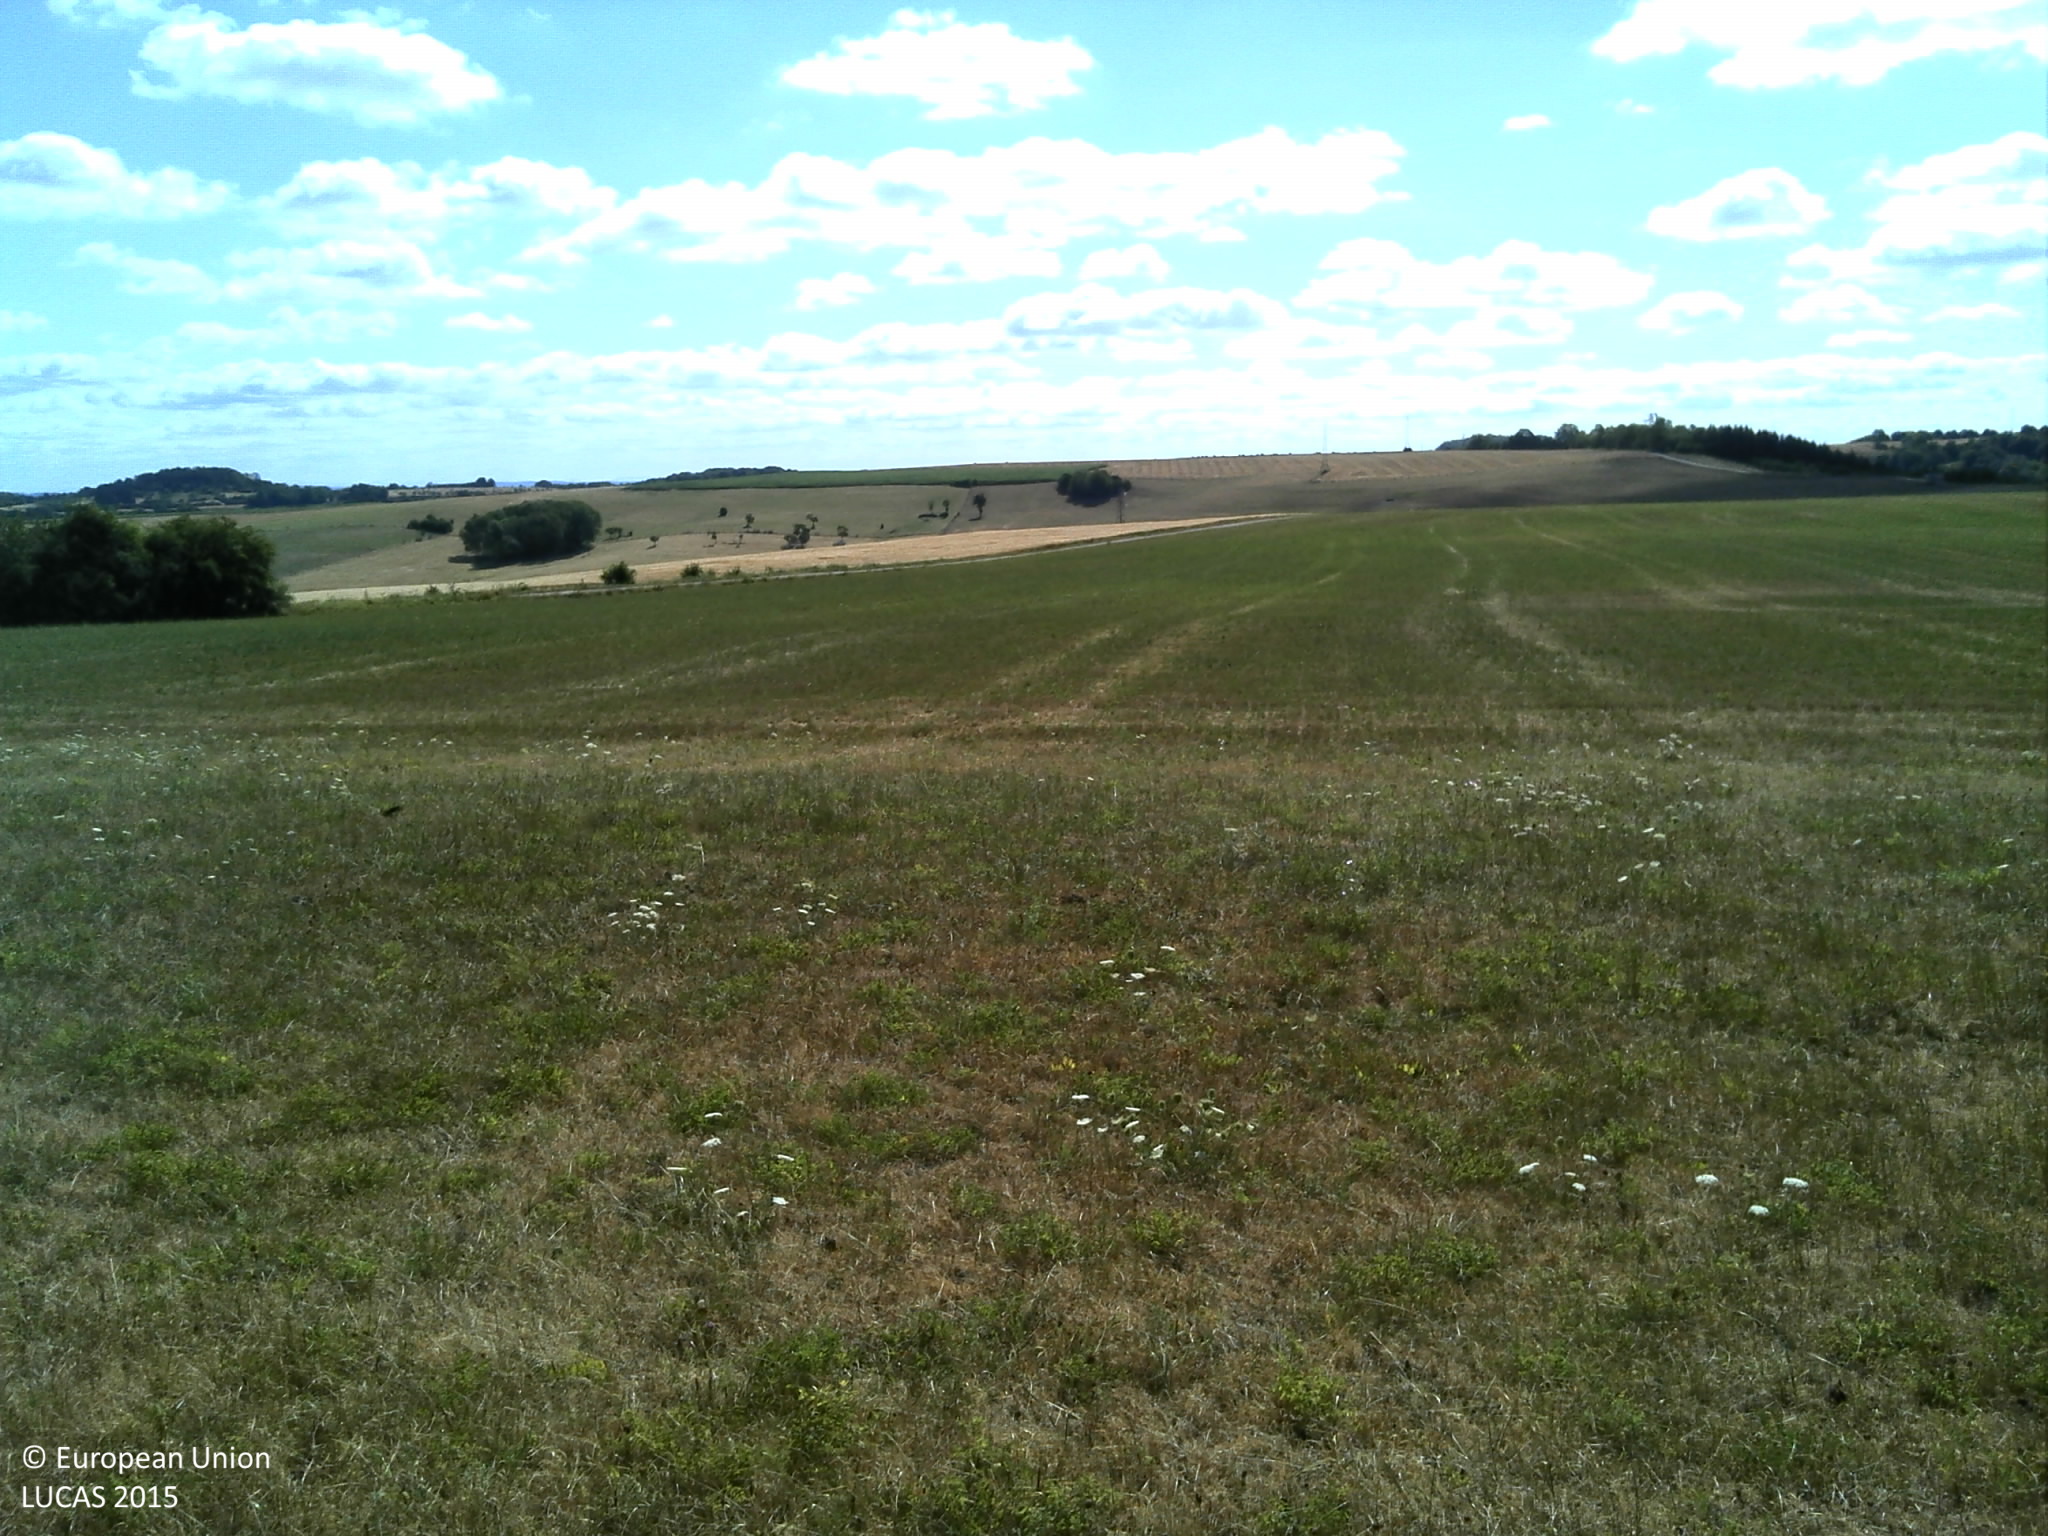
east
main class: Grassland
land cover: Grassland without tree/shrub cover
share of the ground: > 75 %
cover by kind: herbaceous plants 100 %
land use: Agriculture (excluding fallow land and kitchen gardens)
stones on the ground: 10 - 25 %
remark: Harvested field
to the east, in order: Grassland without tree/shrub cover; Ditches and canals; Tracks; Grass margins; Common wheat
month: July
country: FR
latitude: 48.2401
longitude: 5.9742
